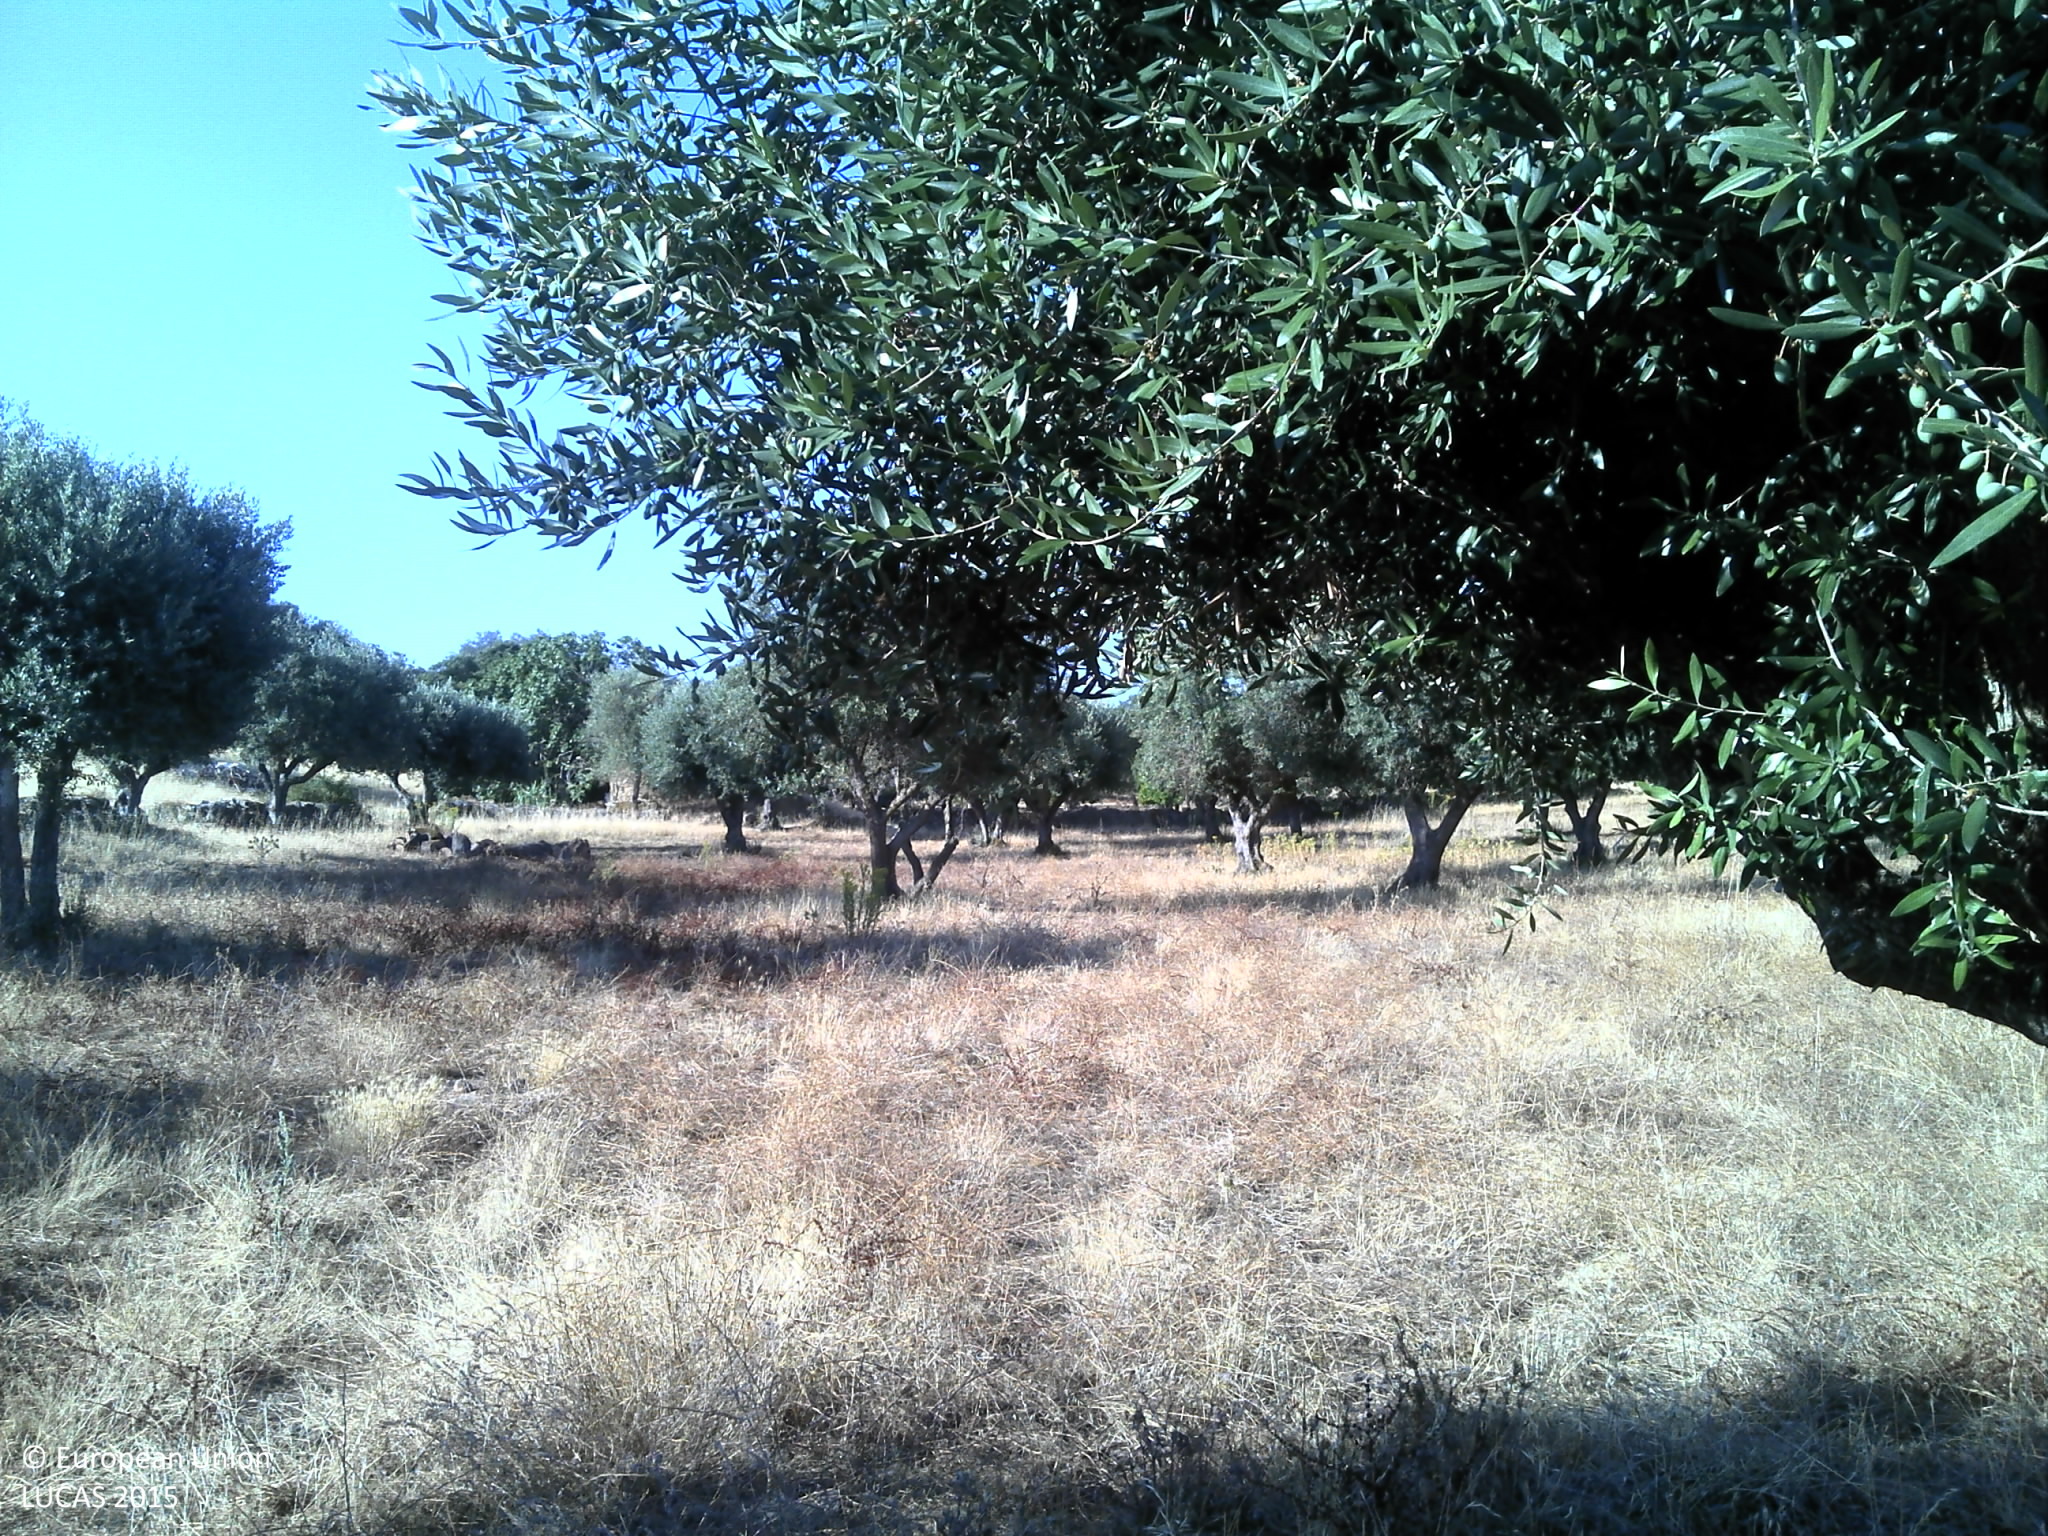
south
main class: Cropland
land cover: Olive groves
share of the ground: 25 - 50 %
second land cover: Grassland without tree/shrub cover
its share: 25 - 50 %
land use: Agriculture (excluding fallow land and kitchen gardens)
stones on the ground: < 10 %
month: July
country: PT
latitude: 38.5545
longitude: -7.4827
